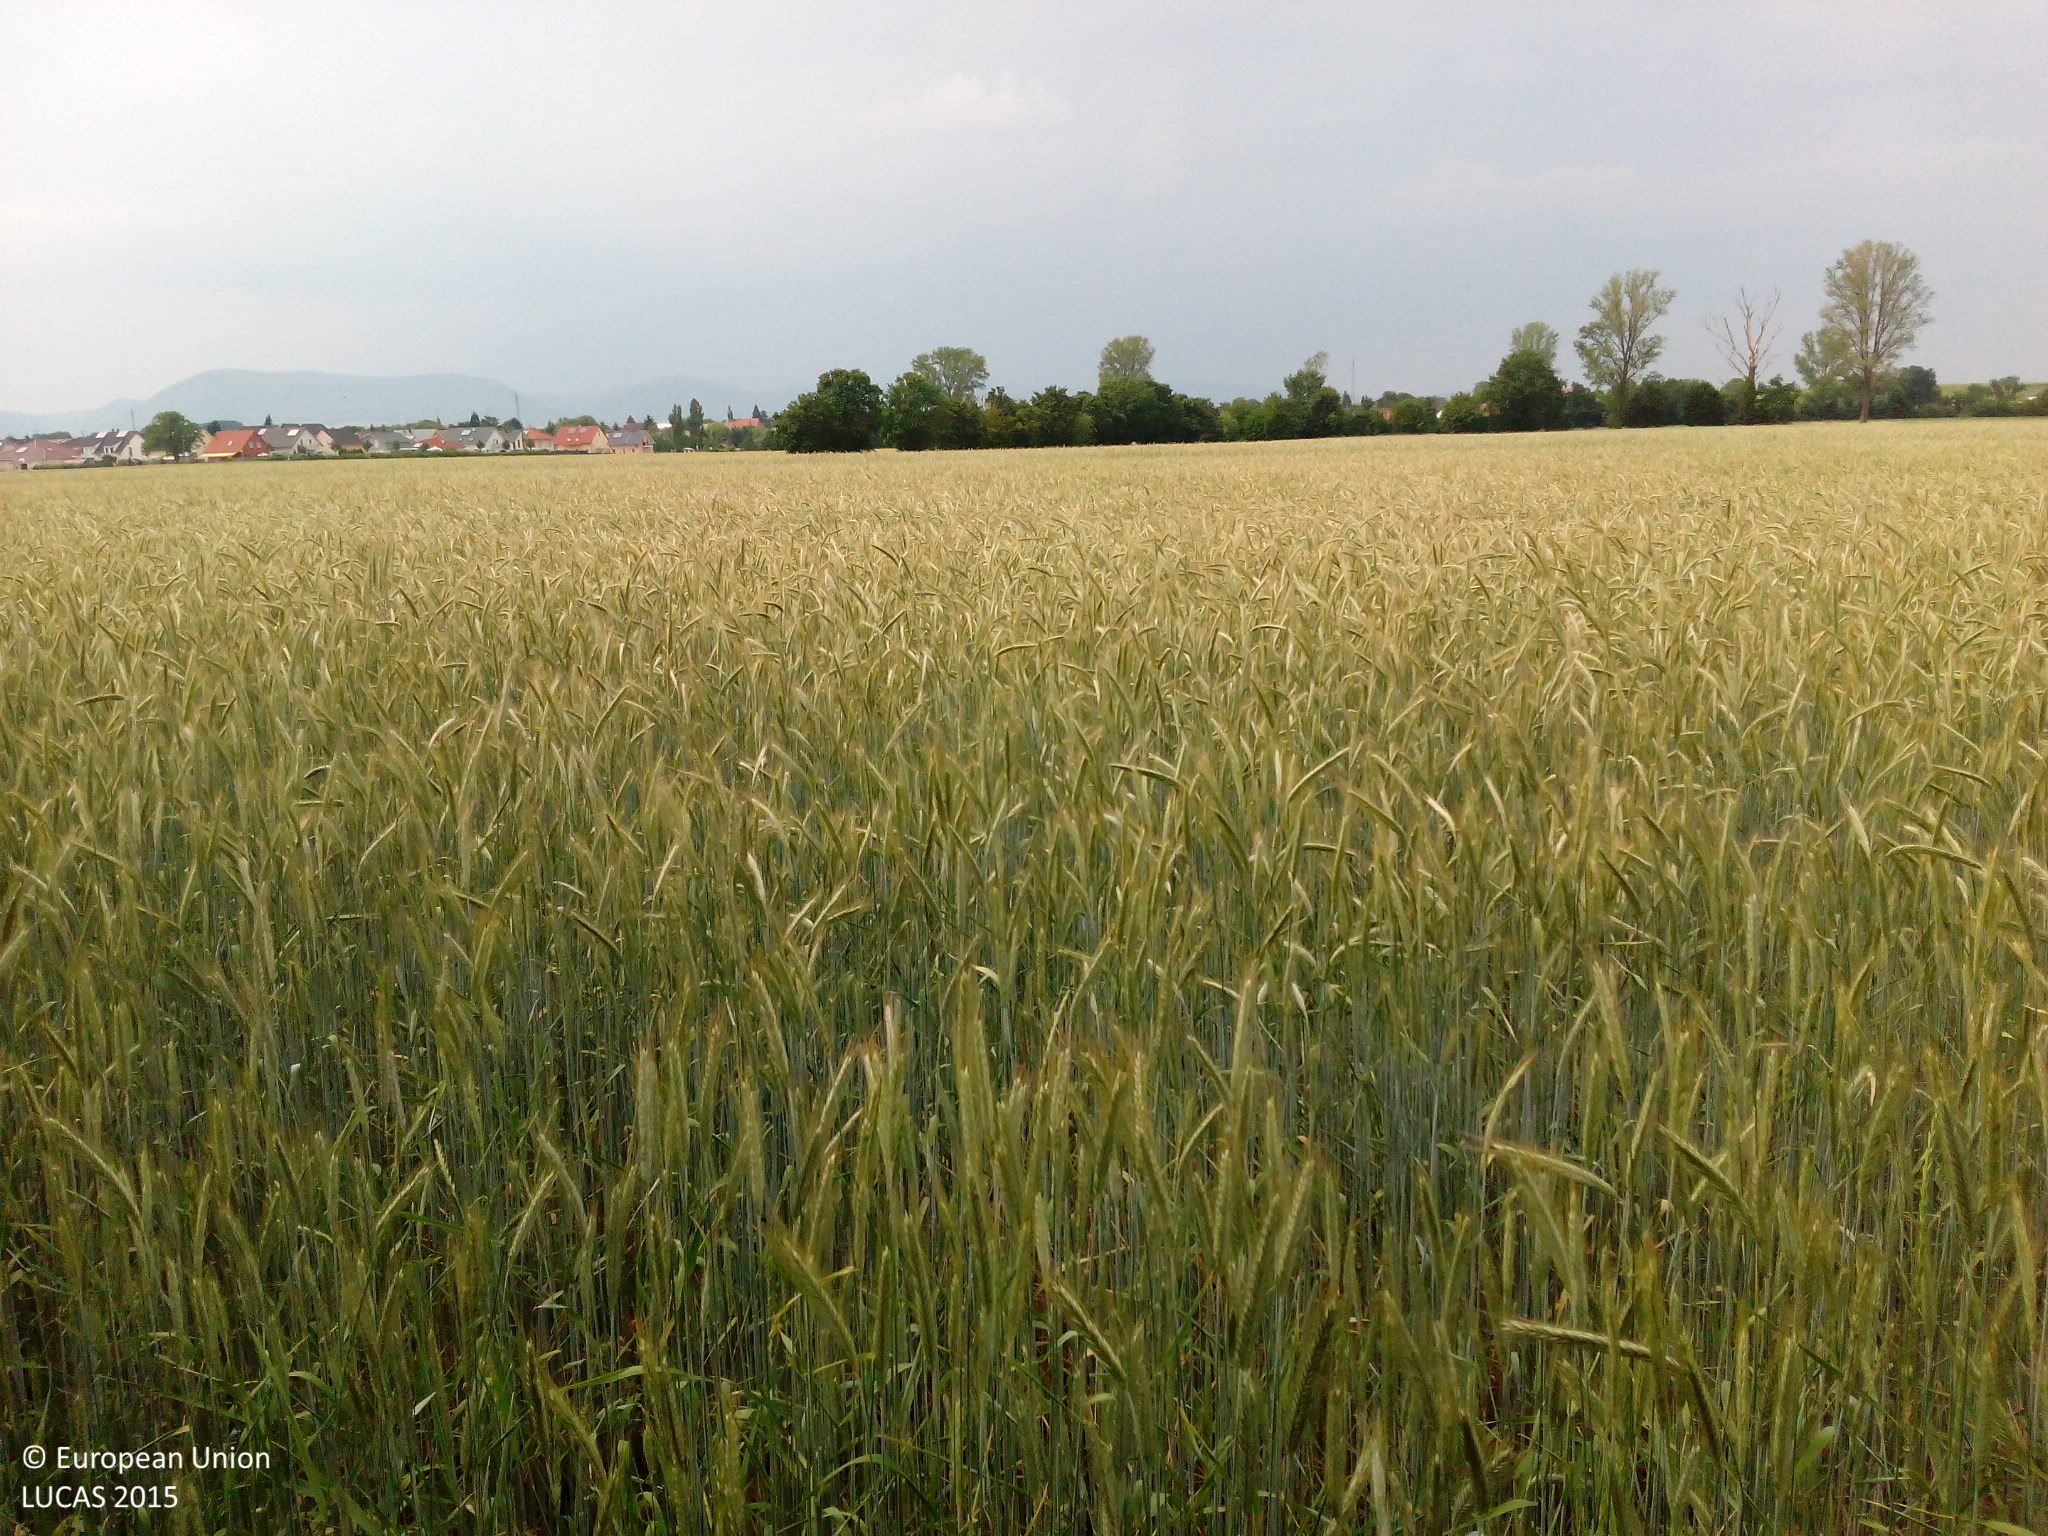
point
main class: Cropland
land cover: Rye
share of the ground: > 75 %
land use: Agriculture (excluding fallow land and kitchen gardens)
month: June
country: DE
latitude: 49.2162
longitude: 8.1747
